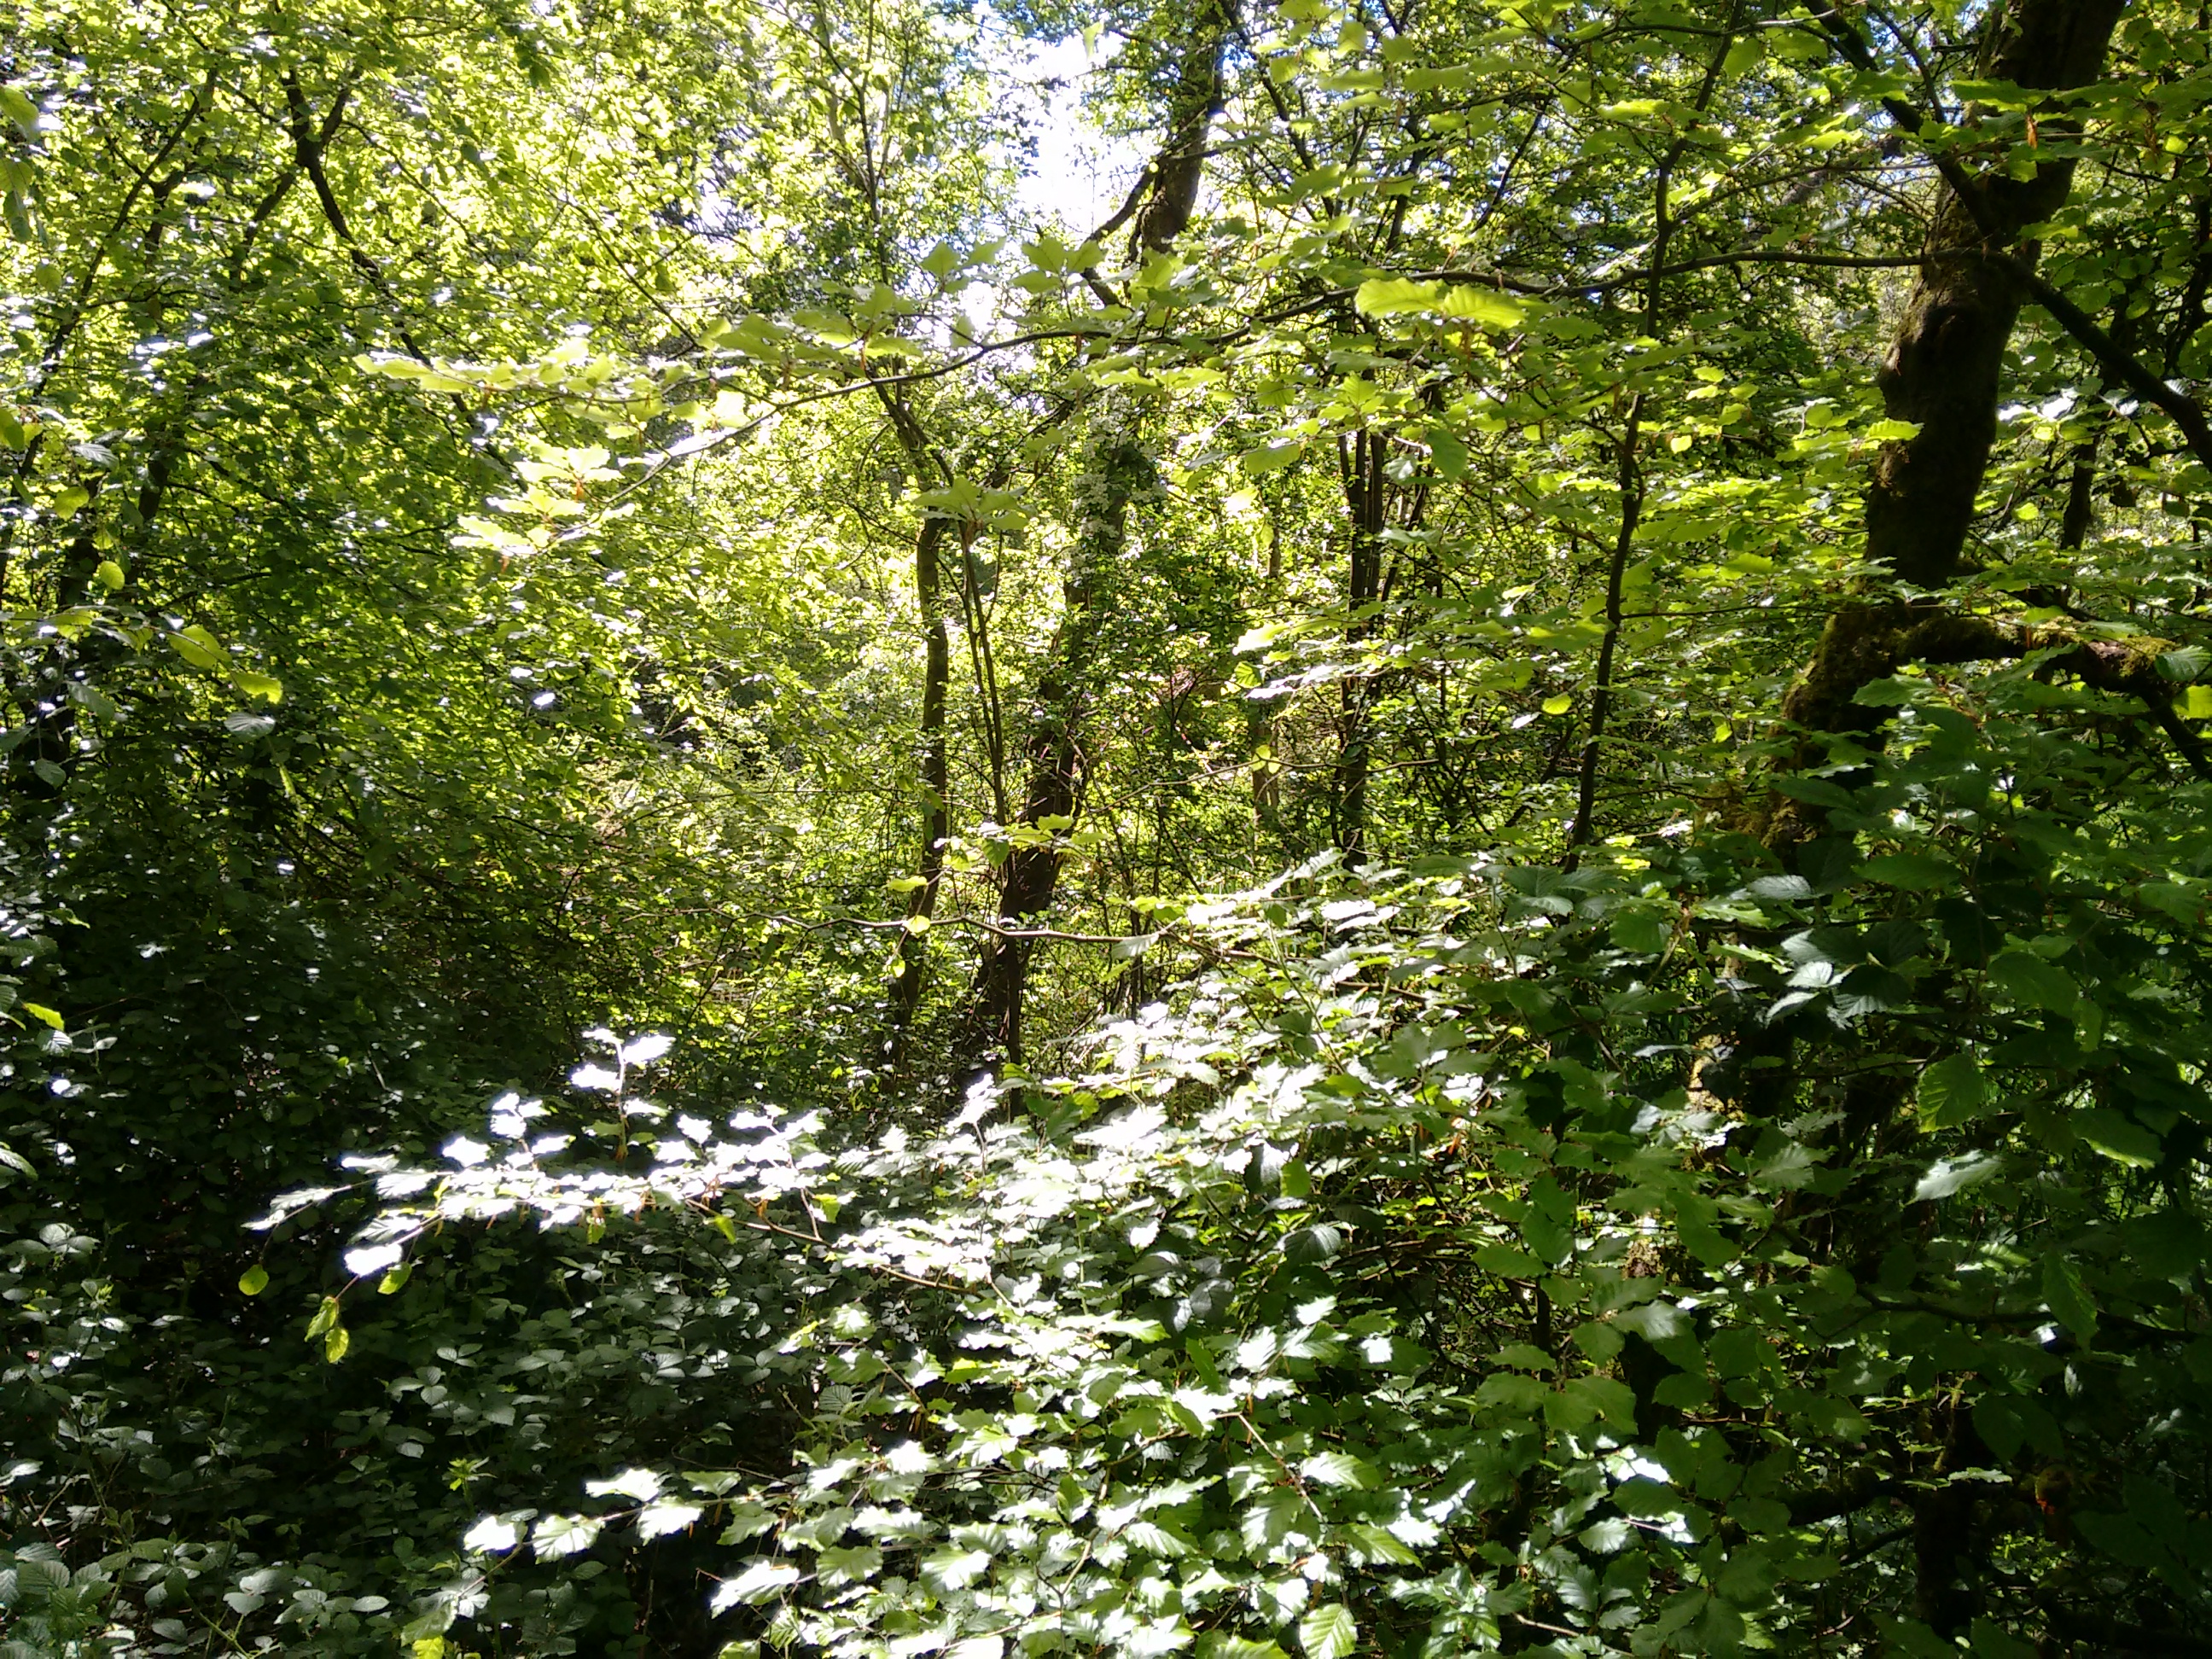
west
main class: Woodland
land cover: Broadleaved woodland
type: beech forest
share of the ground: > 75 %
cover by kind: broadleaved forest trees 85 %, shrubs 10 %, herbaceous plants 5 %
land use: Semi-natural and natural areas not in use
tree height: > 5 m
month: May
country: IE
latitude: 53.5901
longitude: -6.7056
